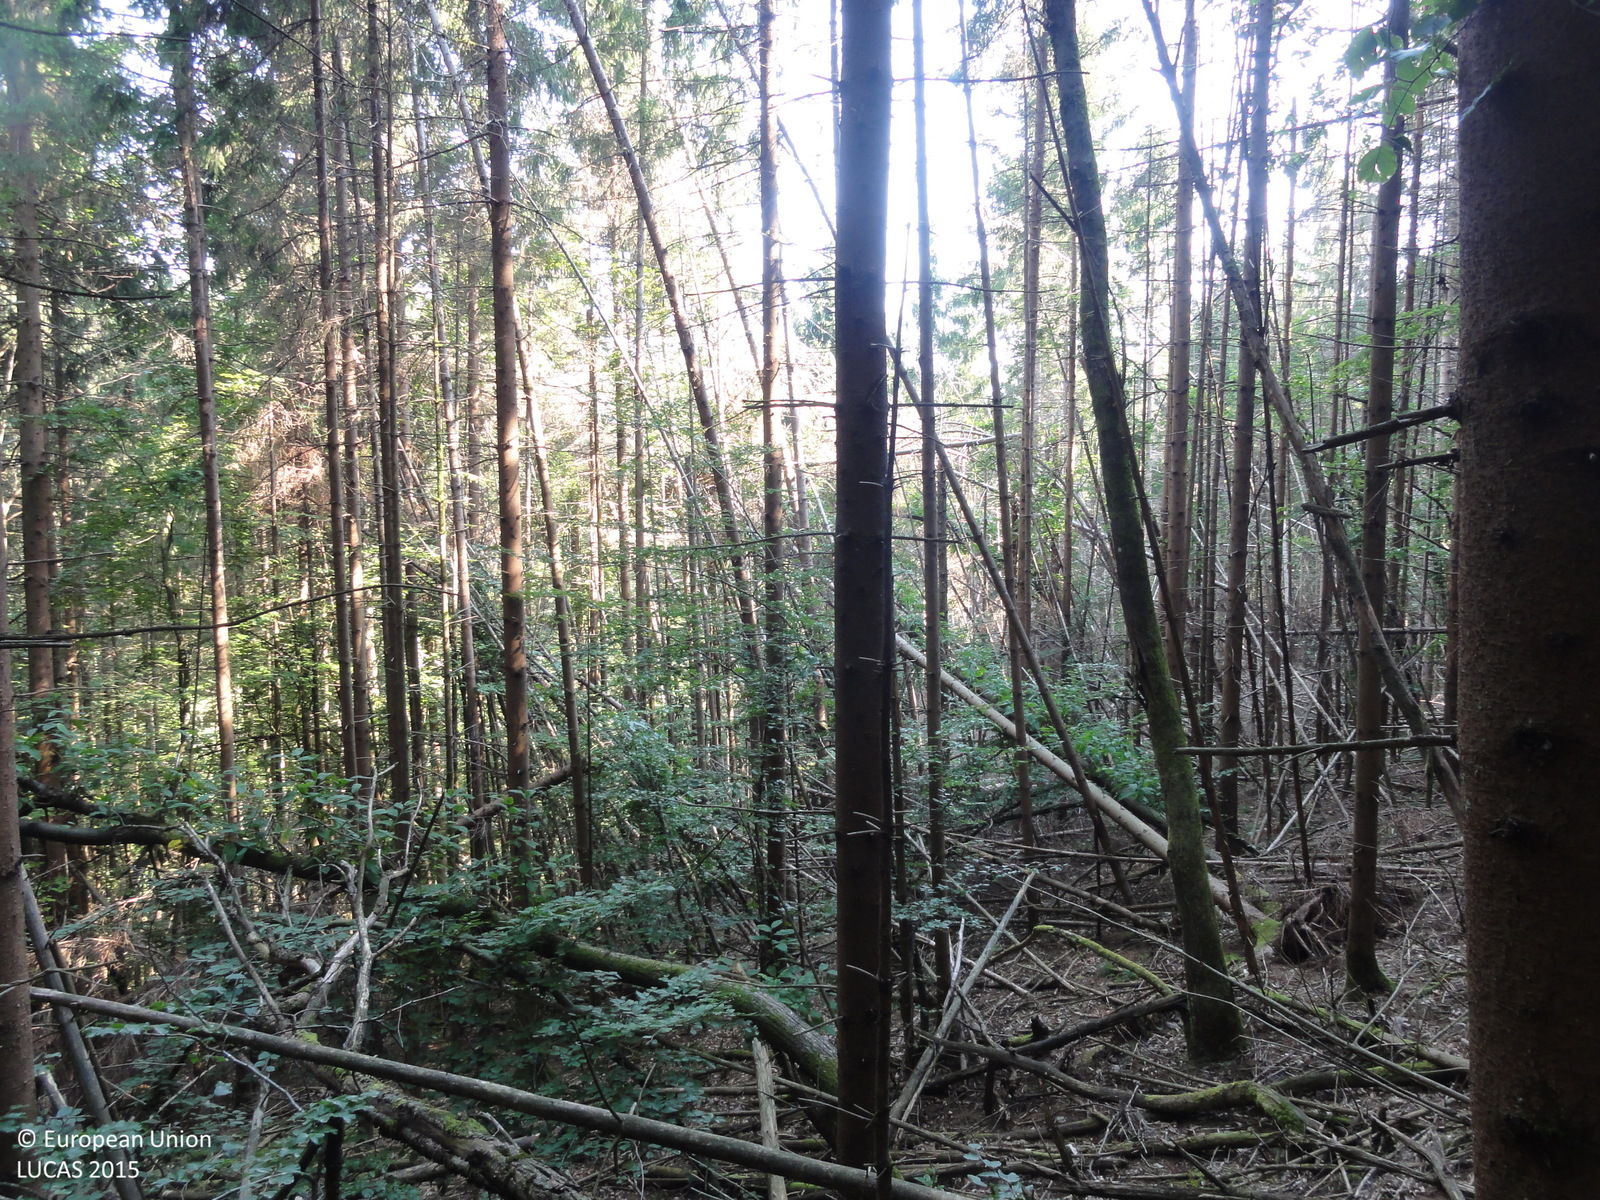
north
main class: Woodland
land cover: Spruce dominated mixed woodland
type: mountainous beech forest
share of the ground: > 75 %
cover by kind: coniferous forest trees 65 %, broadleaved forest trees 30 %, herbaceous plants 5 %
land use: Forestry
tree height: > 5 m
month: August
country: SI
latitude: 45.8897
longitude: 15.0354
